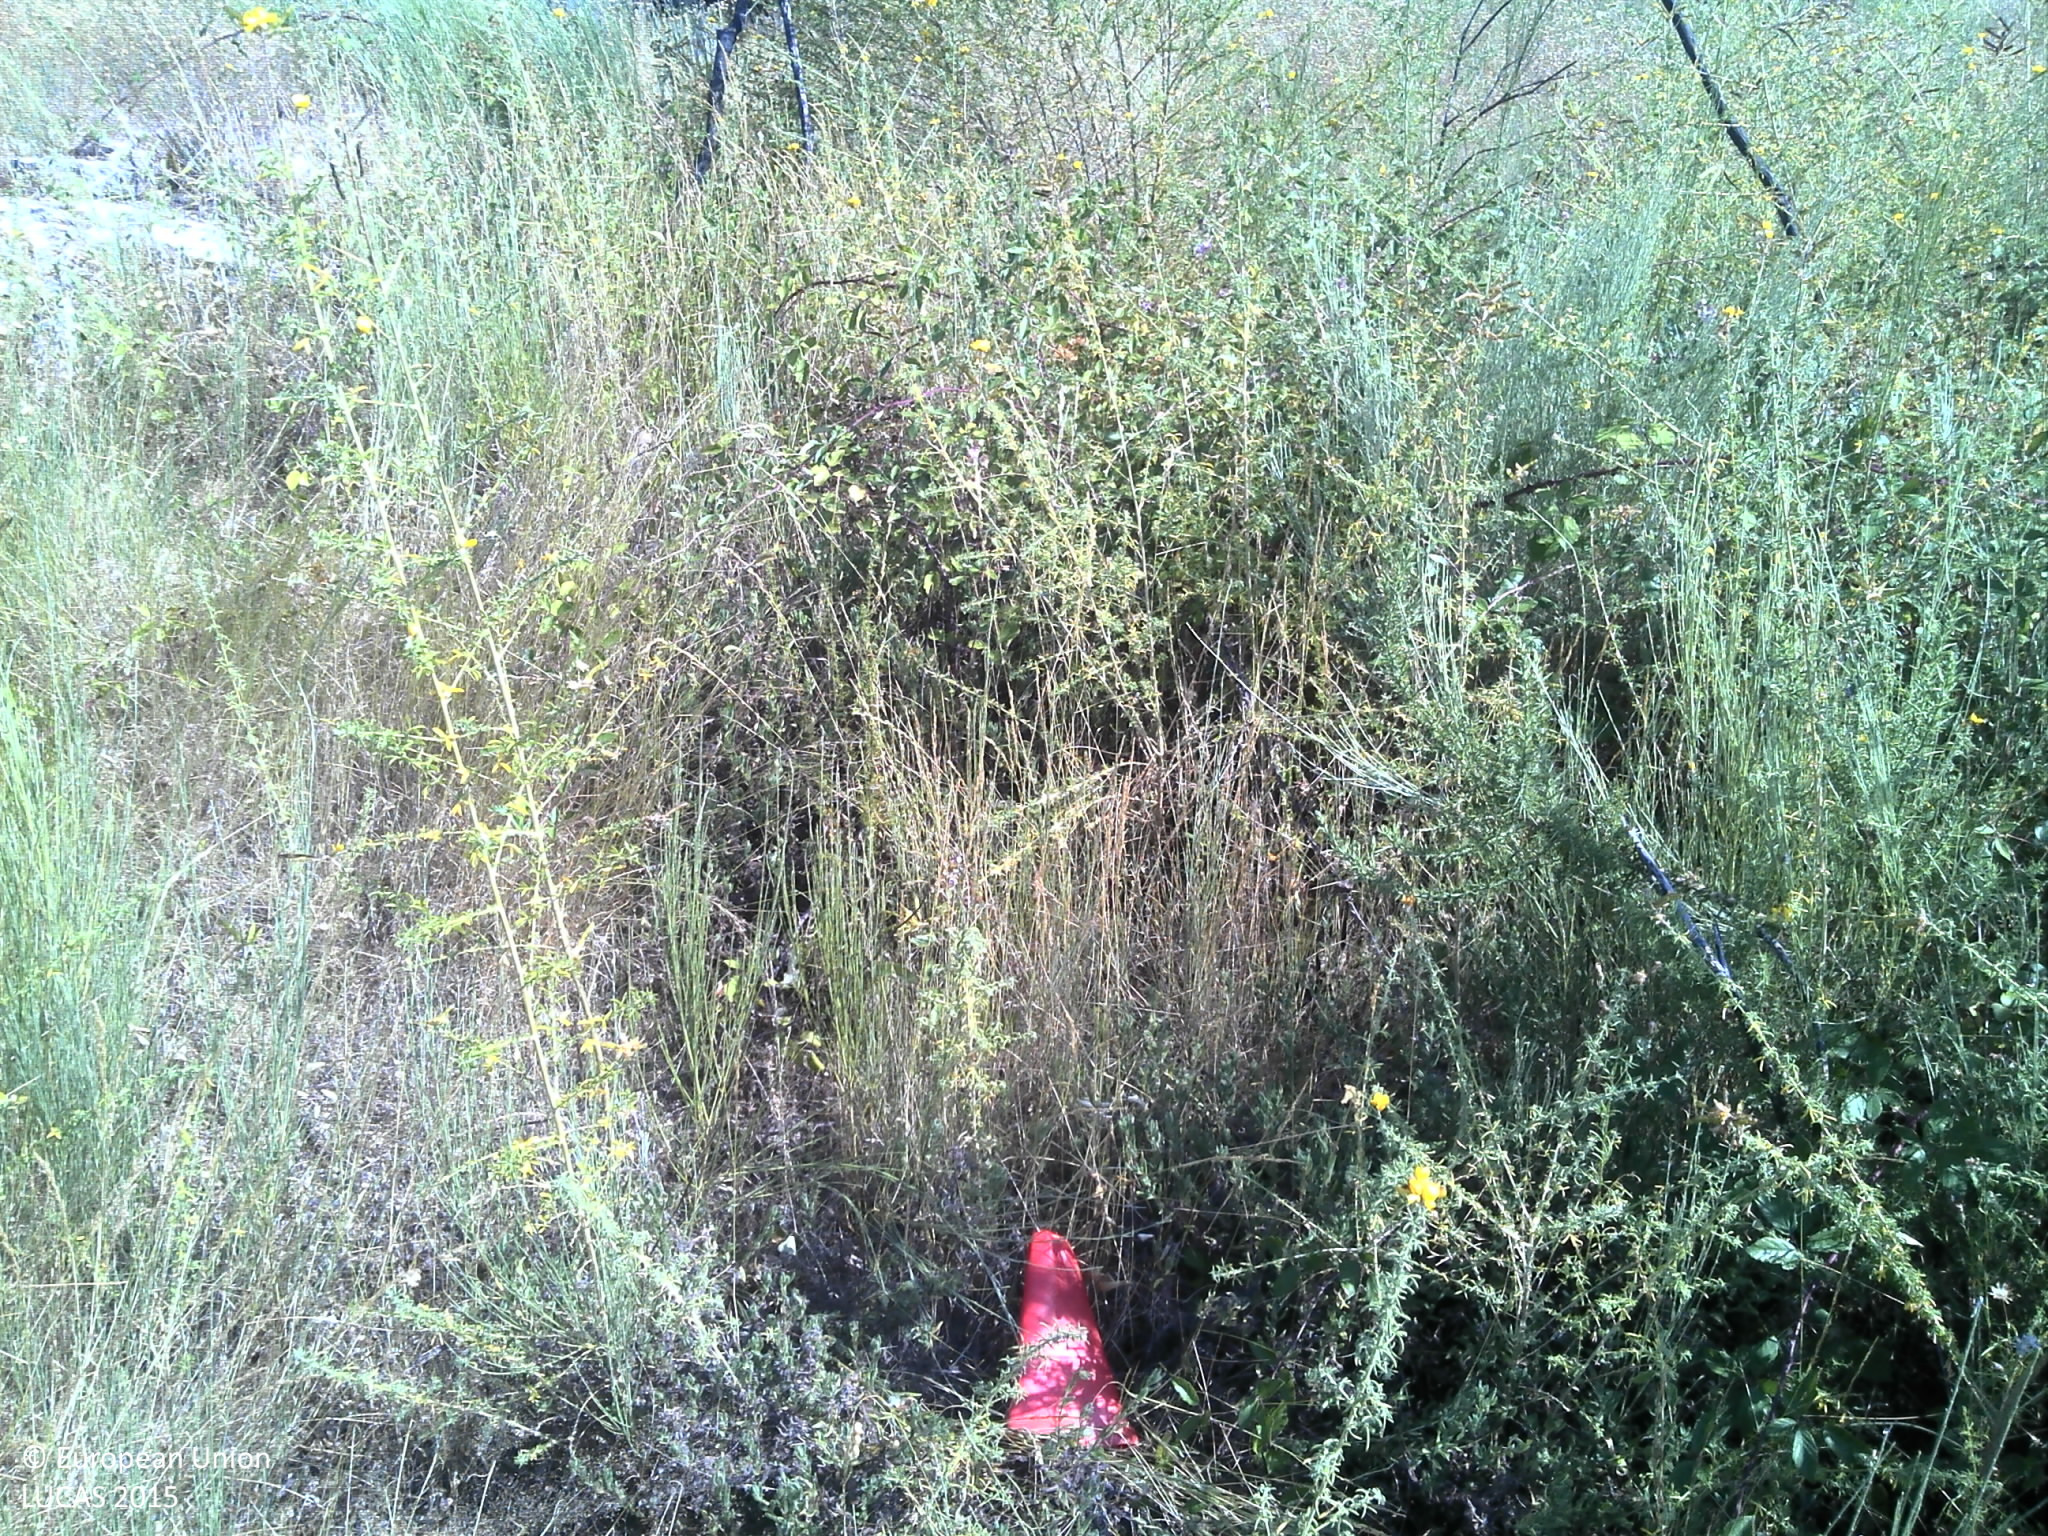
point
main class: Shrubland
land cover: Shrubland without tree cover
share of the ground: > 75 %
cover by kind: shrubs 80 %, unconsolidated bare surface 15 %, consolidated bare surface 5 %
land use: Semi-natural and natural areas not in use
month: June
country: PT
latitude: 40.5601
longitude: -7.9211
